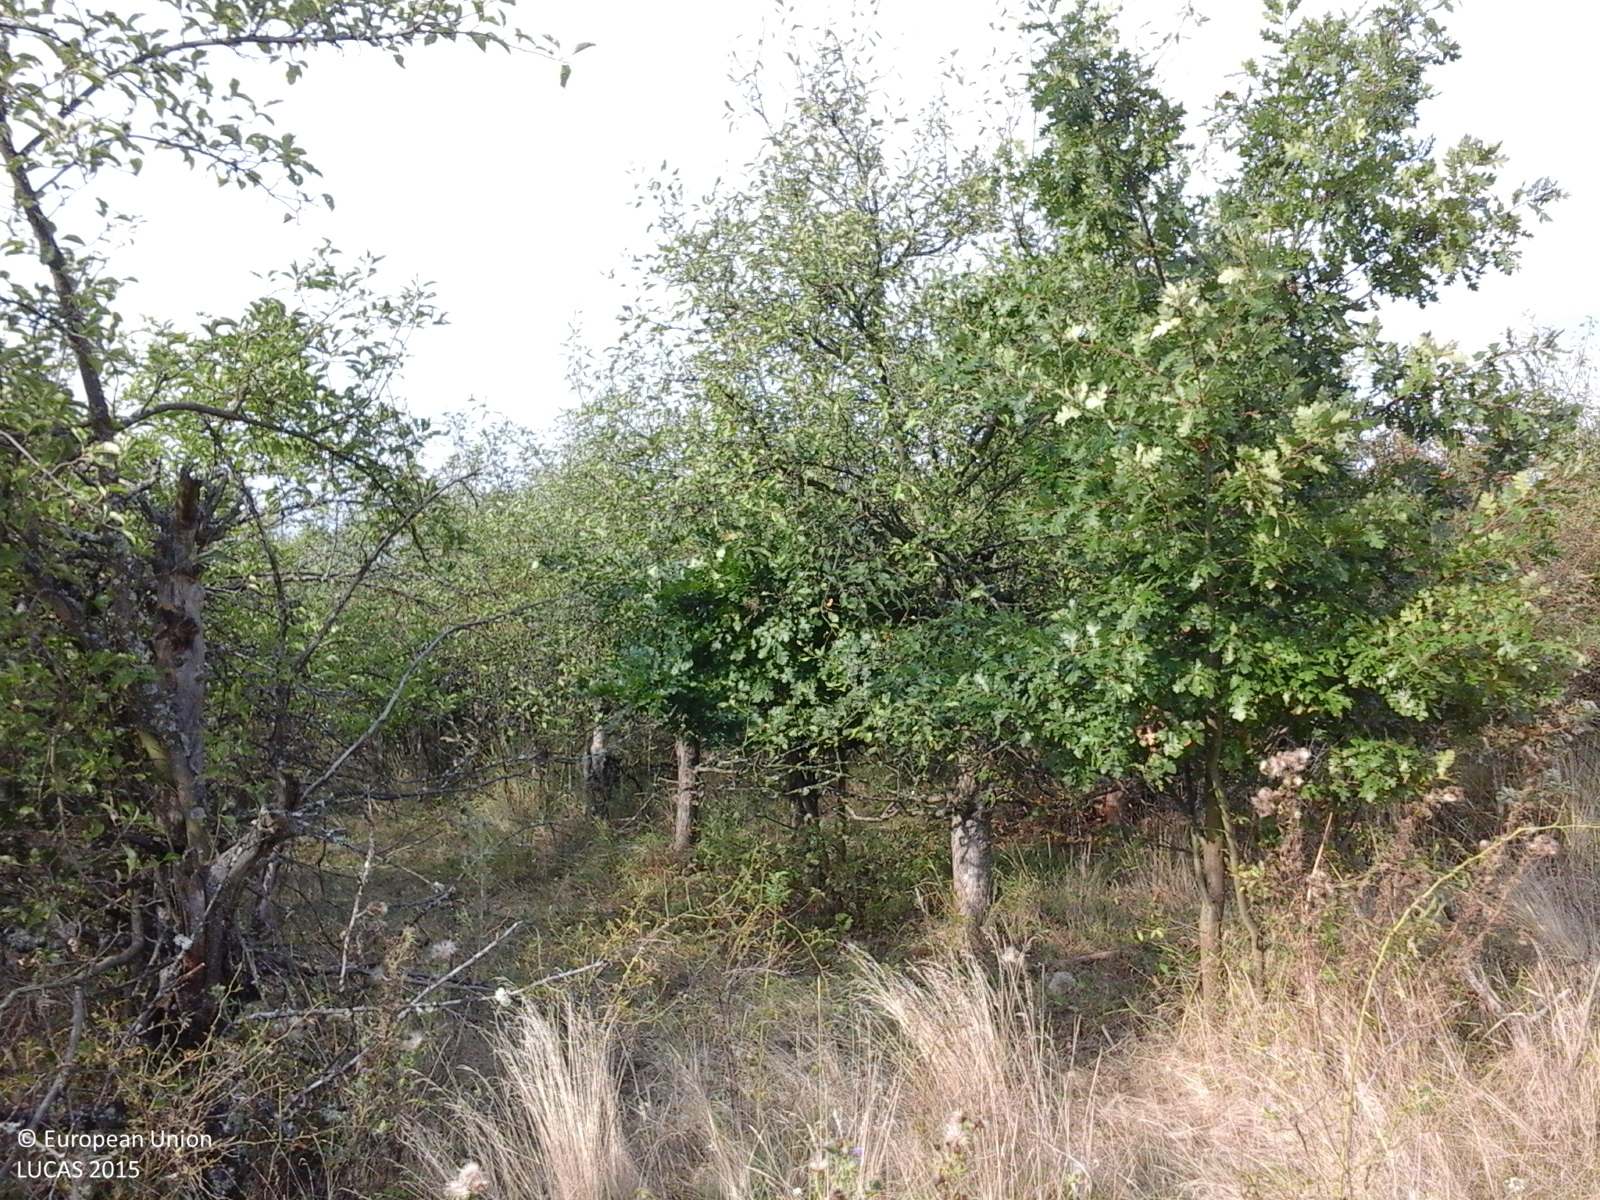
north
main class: Cropland
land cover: Apple fruit
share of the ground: > 75 %
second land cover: Grassland without tree/shrub cover
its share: > 75 %
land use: Agriculture (excluding fallow land and kitchen gardens)
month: August
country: RO
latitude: 46.0570
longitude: 21.6576
